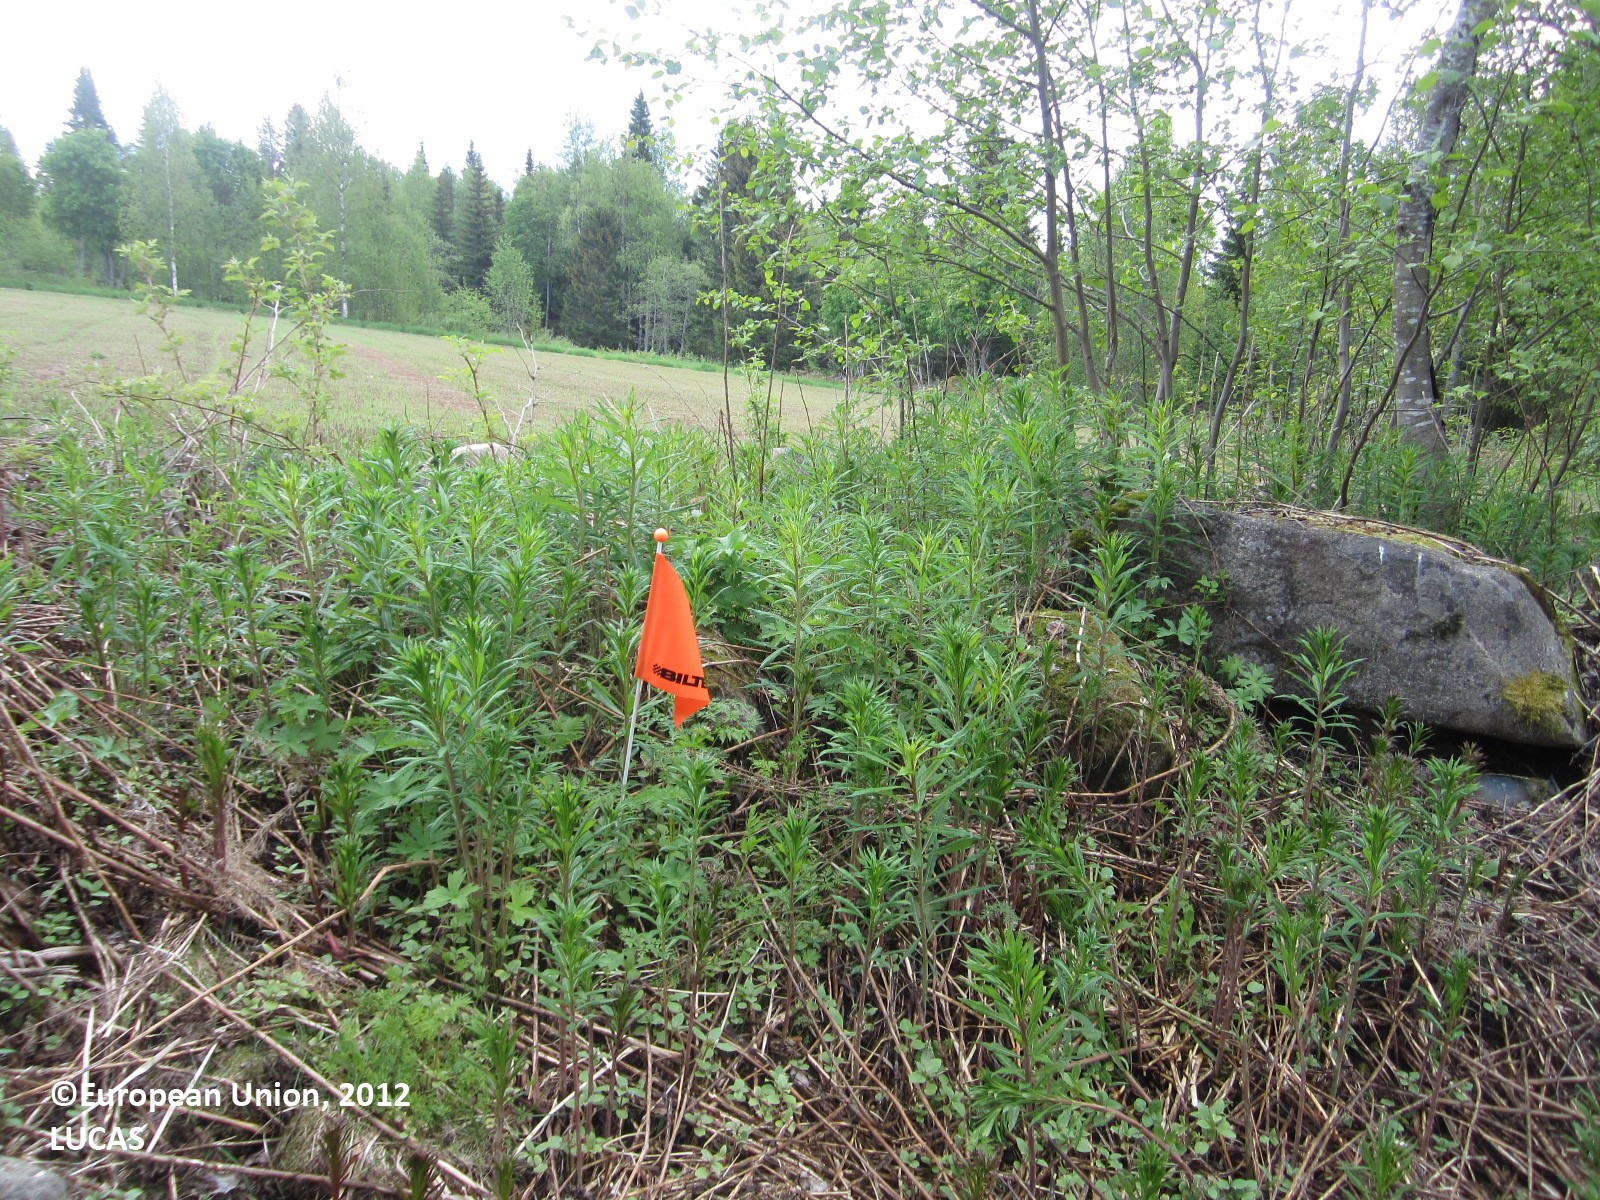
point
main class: Woodland
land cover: Broadleaved woodland
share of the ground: 10 - 25 %
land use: Forestry
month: June
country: FI
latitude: 64.5212
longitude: 28.7050
